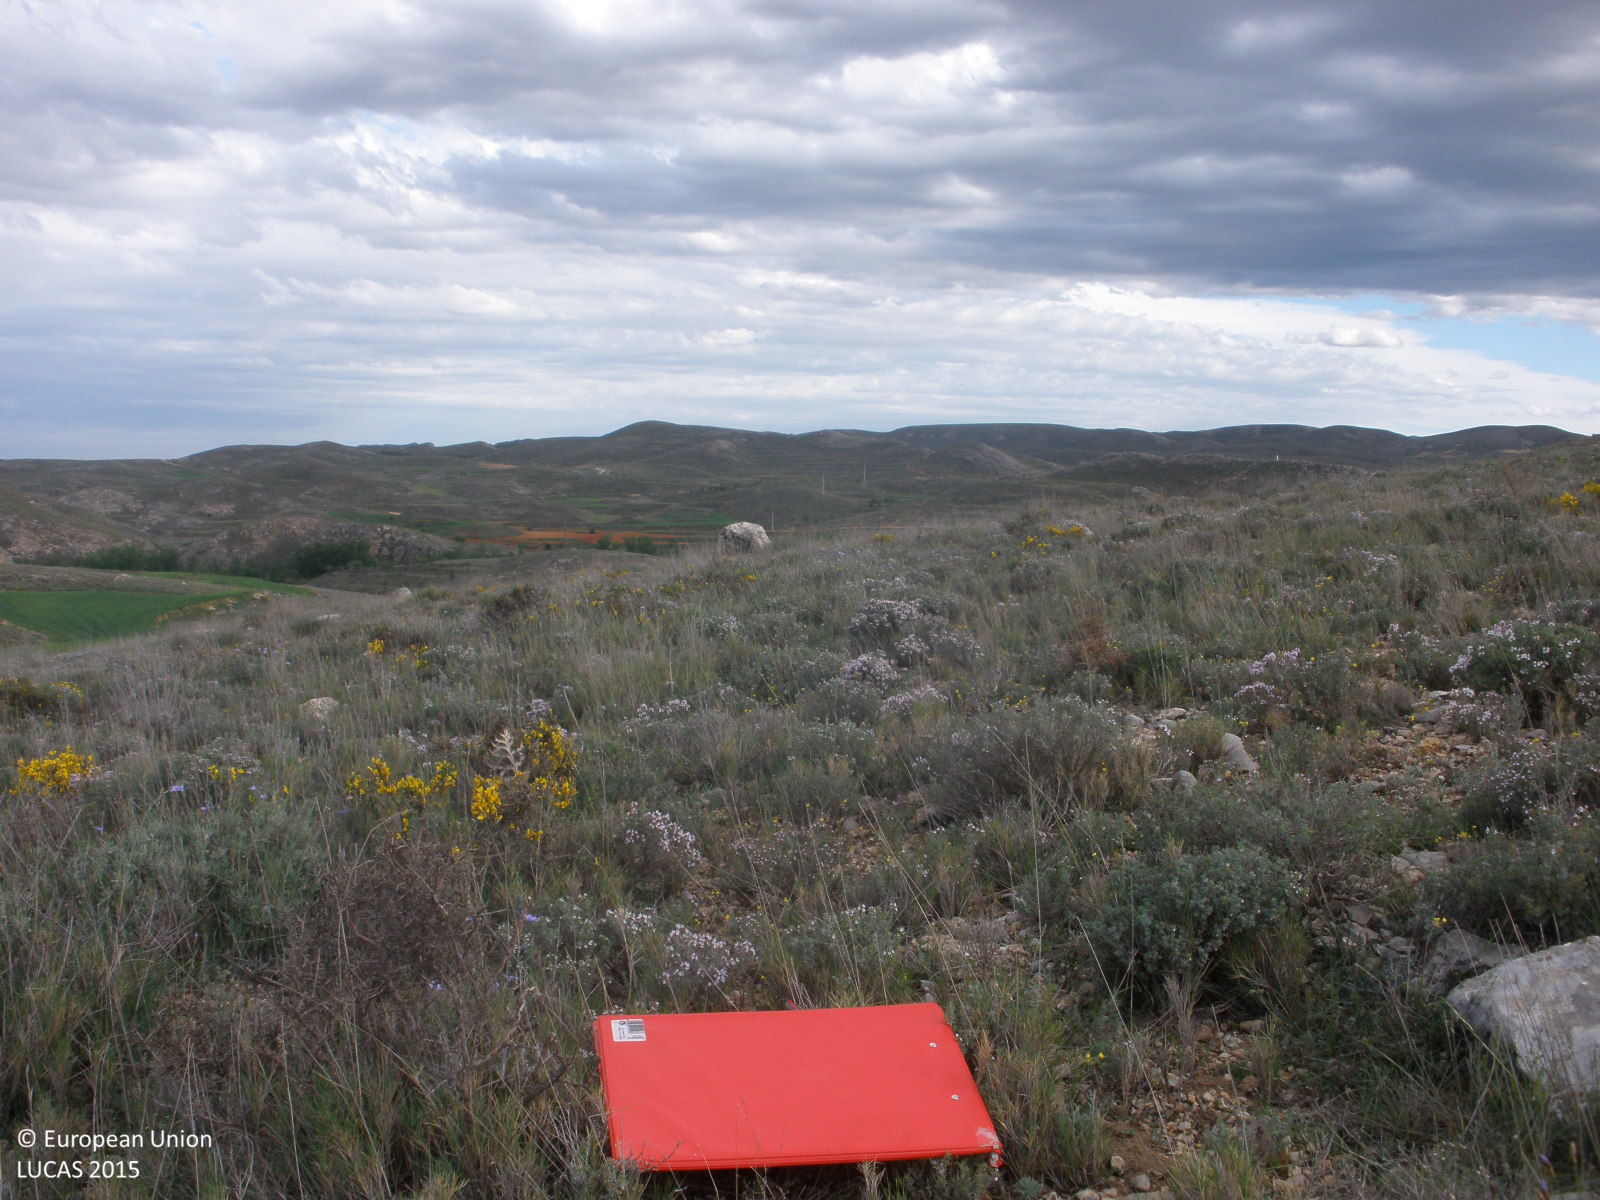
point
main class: Shrubland
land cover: Shrubland without tree cover
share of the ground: 50 - 75 %
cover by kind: shrubs 50 %, herbaceous plants 35 %, consolidated bare surface 15 %
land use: Semi-natural and natural areas not in use
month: May
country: ES
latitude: 41.0642
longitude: -0.8810
